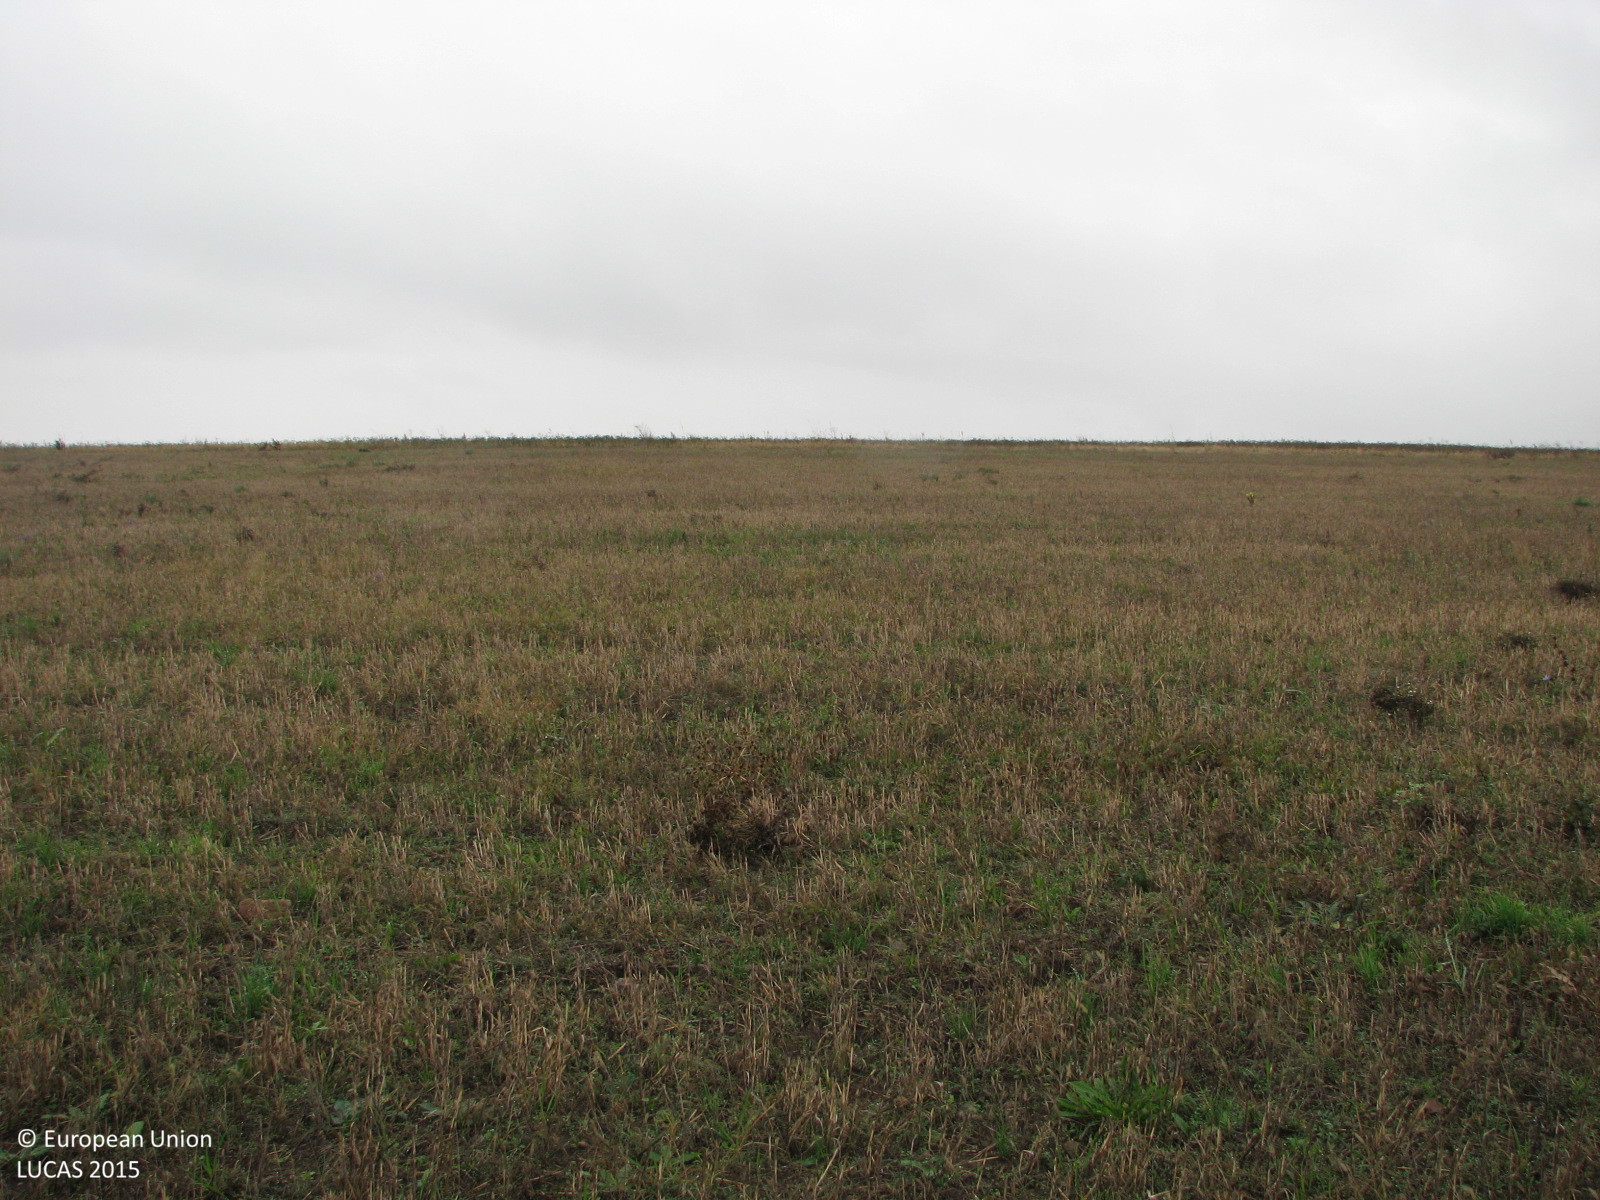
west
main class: Cropland
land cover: Common wheat
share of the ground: 50 - 75 %
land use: Agriculture (excluding fallow land and kitchen gardens)
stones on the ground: < 10 %
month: October
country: BG
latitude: 42.4180
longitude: 26.6840
